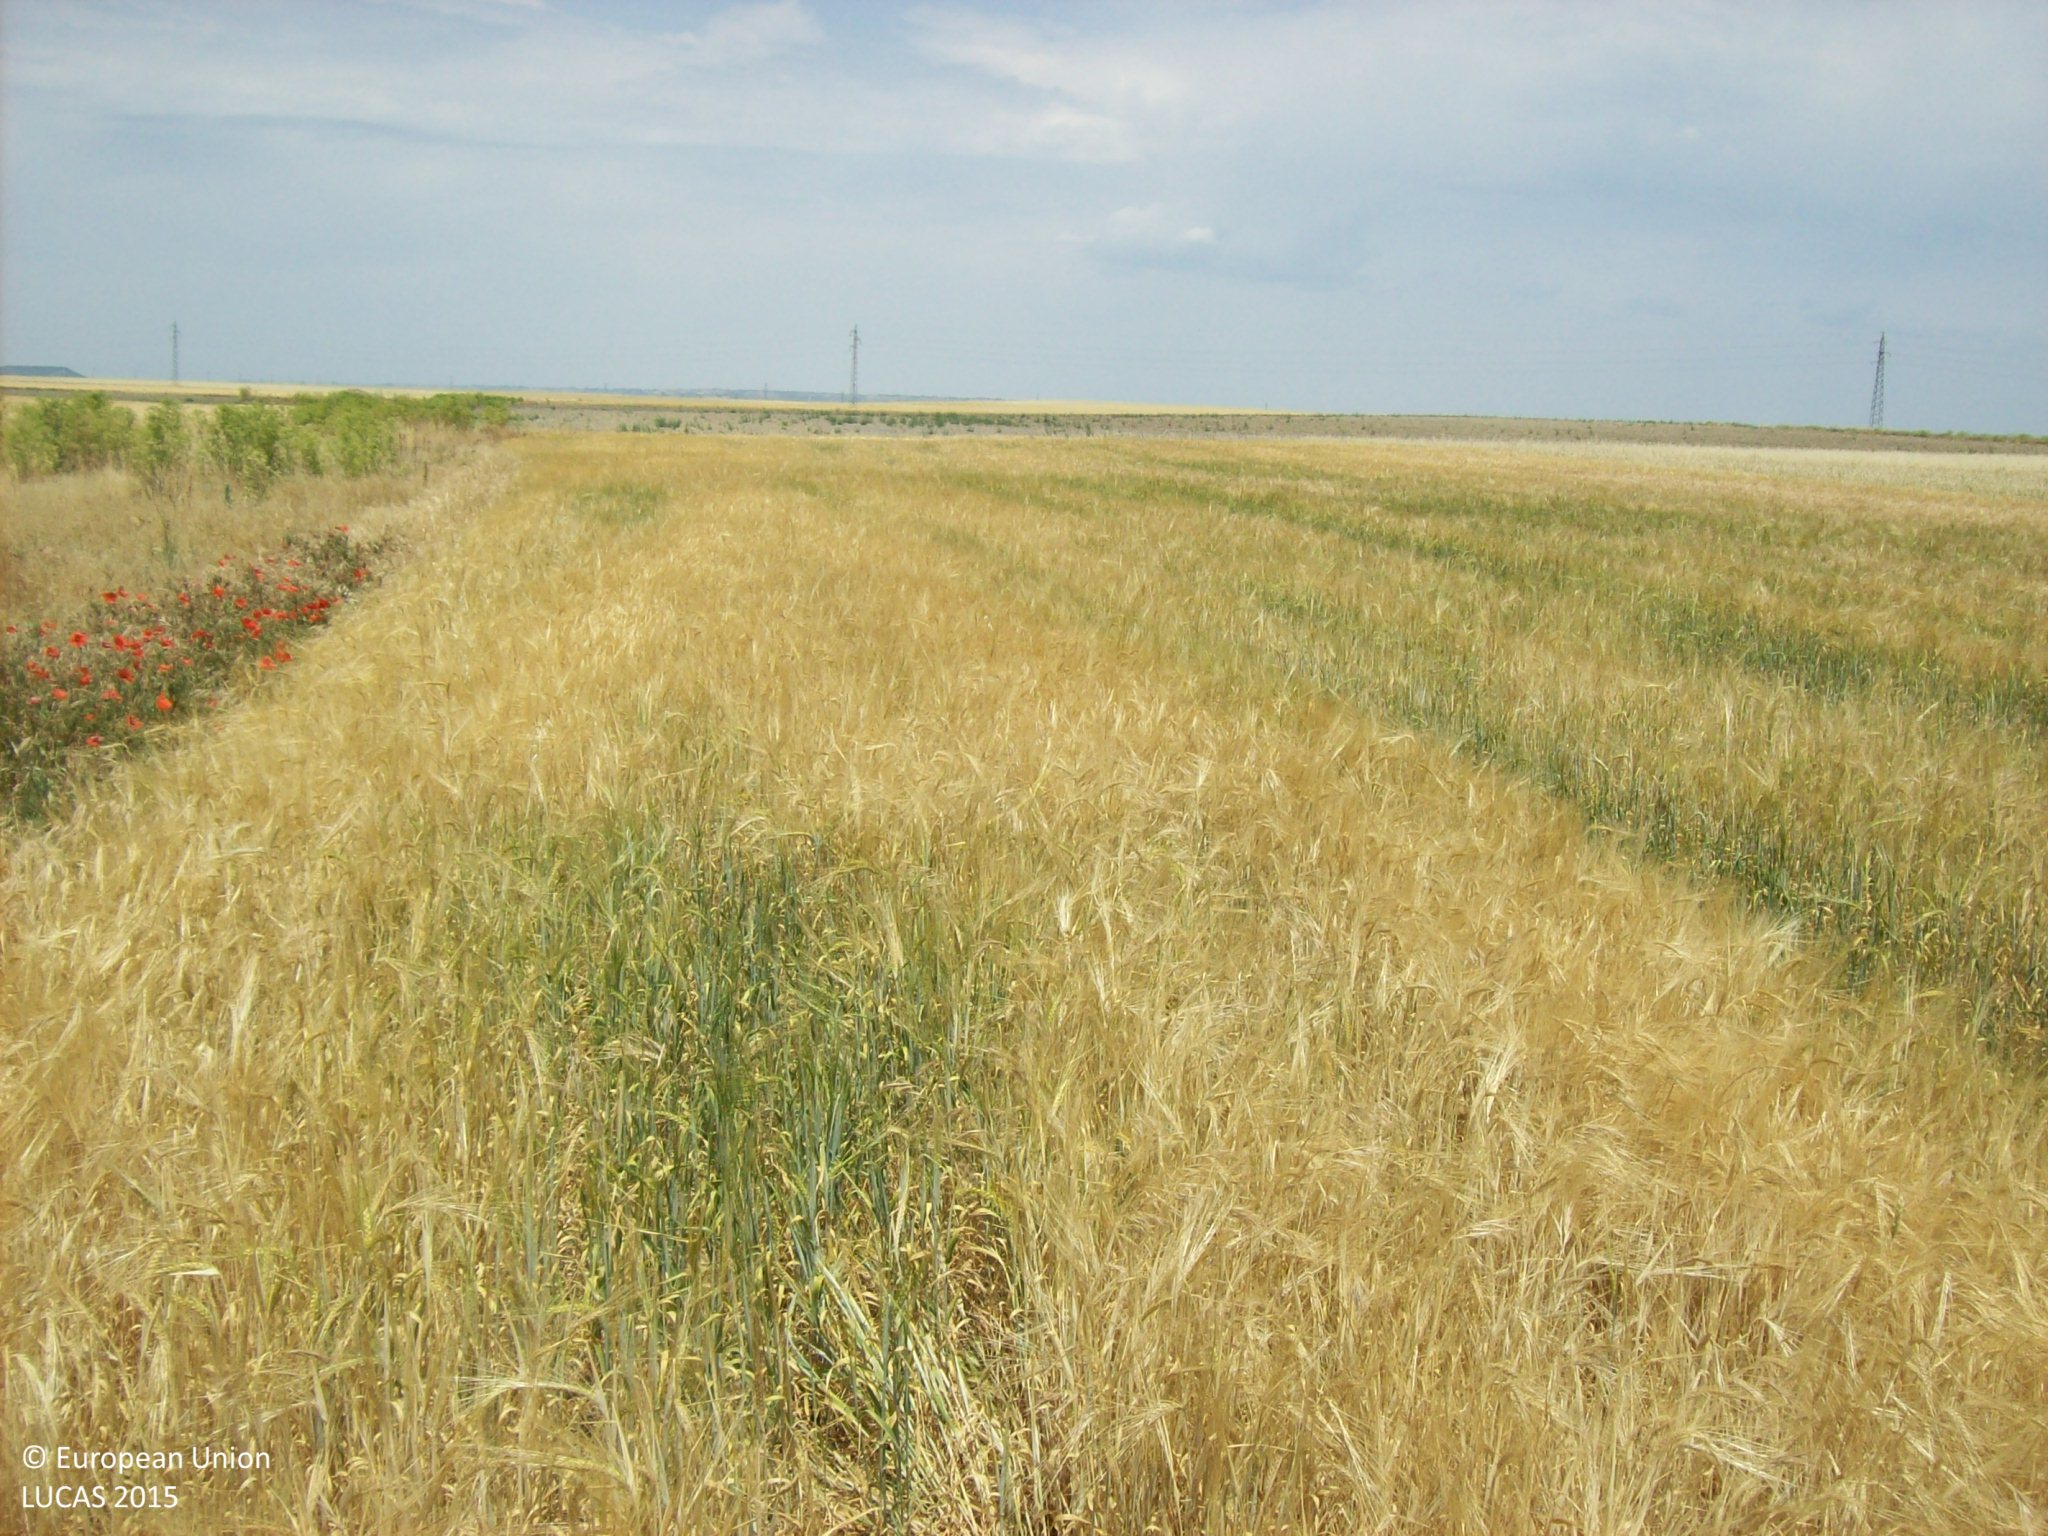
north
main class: Cropland
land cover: Barley
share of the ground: > 75 %
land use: Agriculture (excluding fallow land and kitchen gardens)
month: June
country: ES
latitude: 41.2261
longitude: -4.5792
